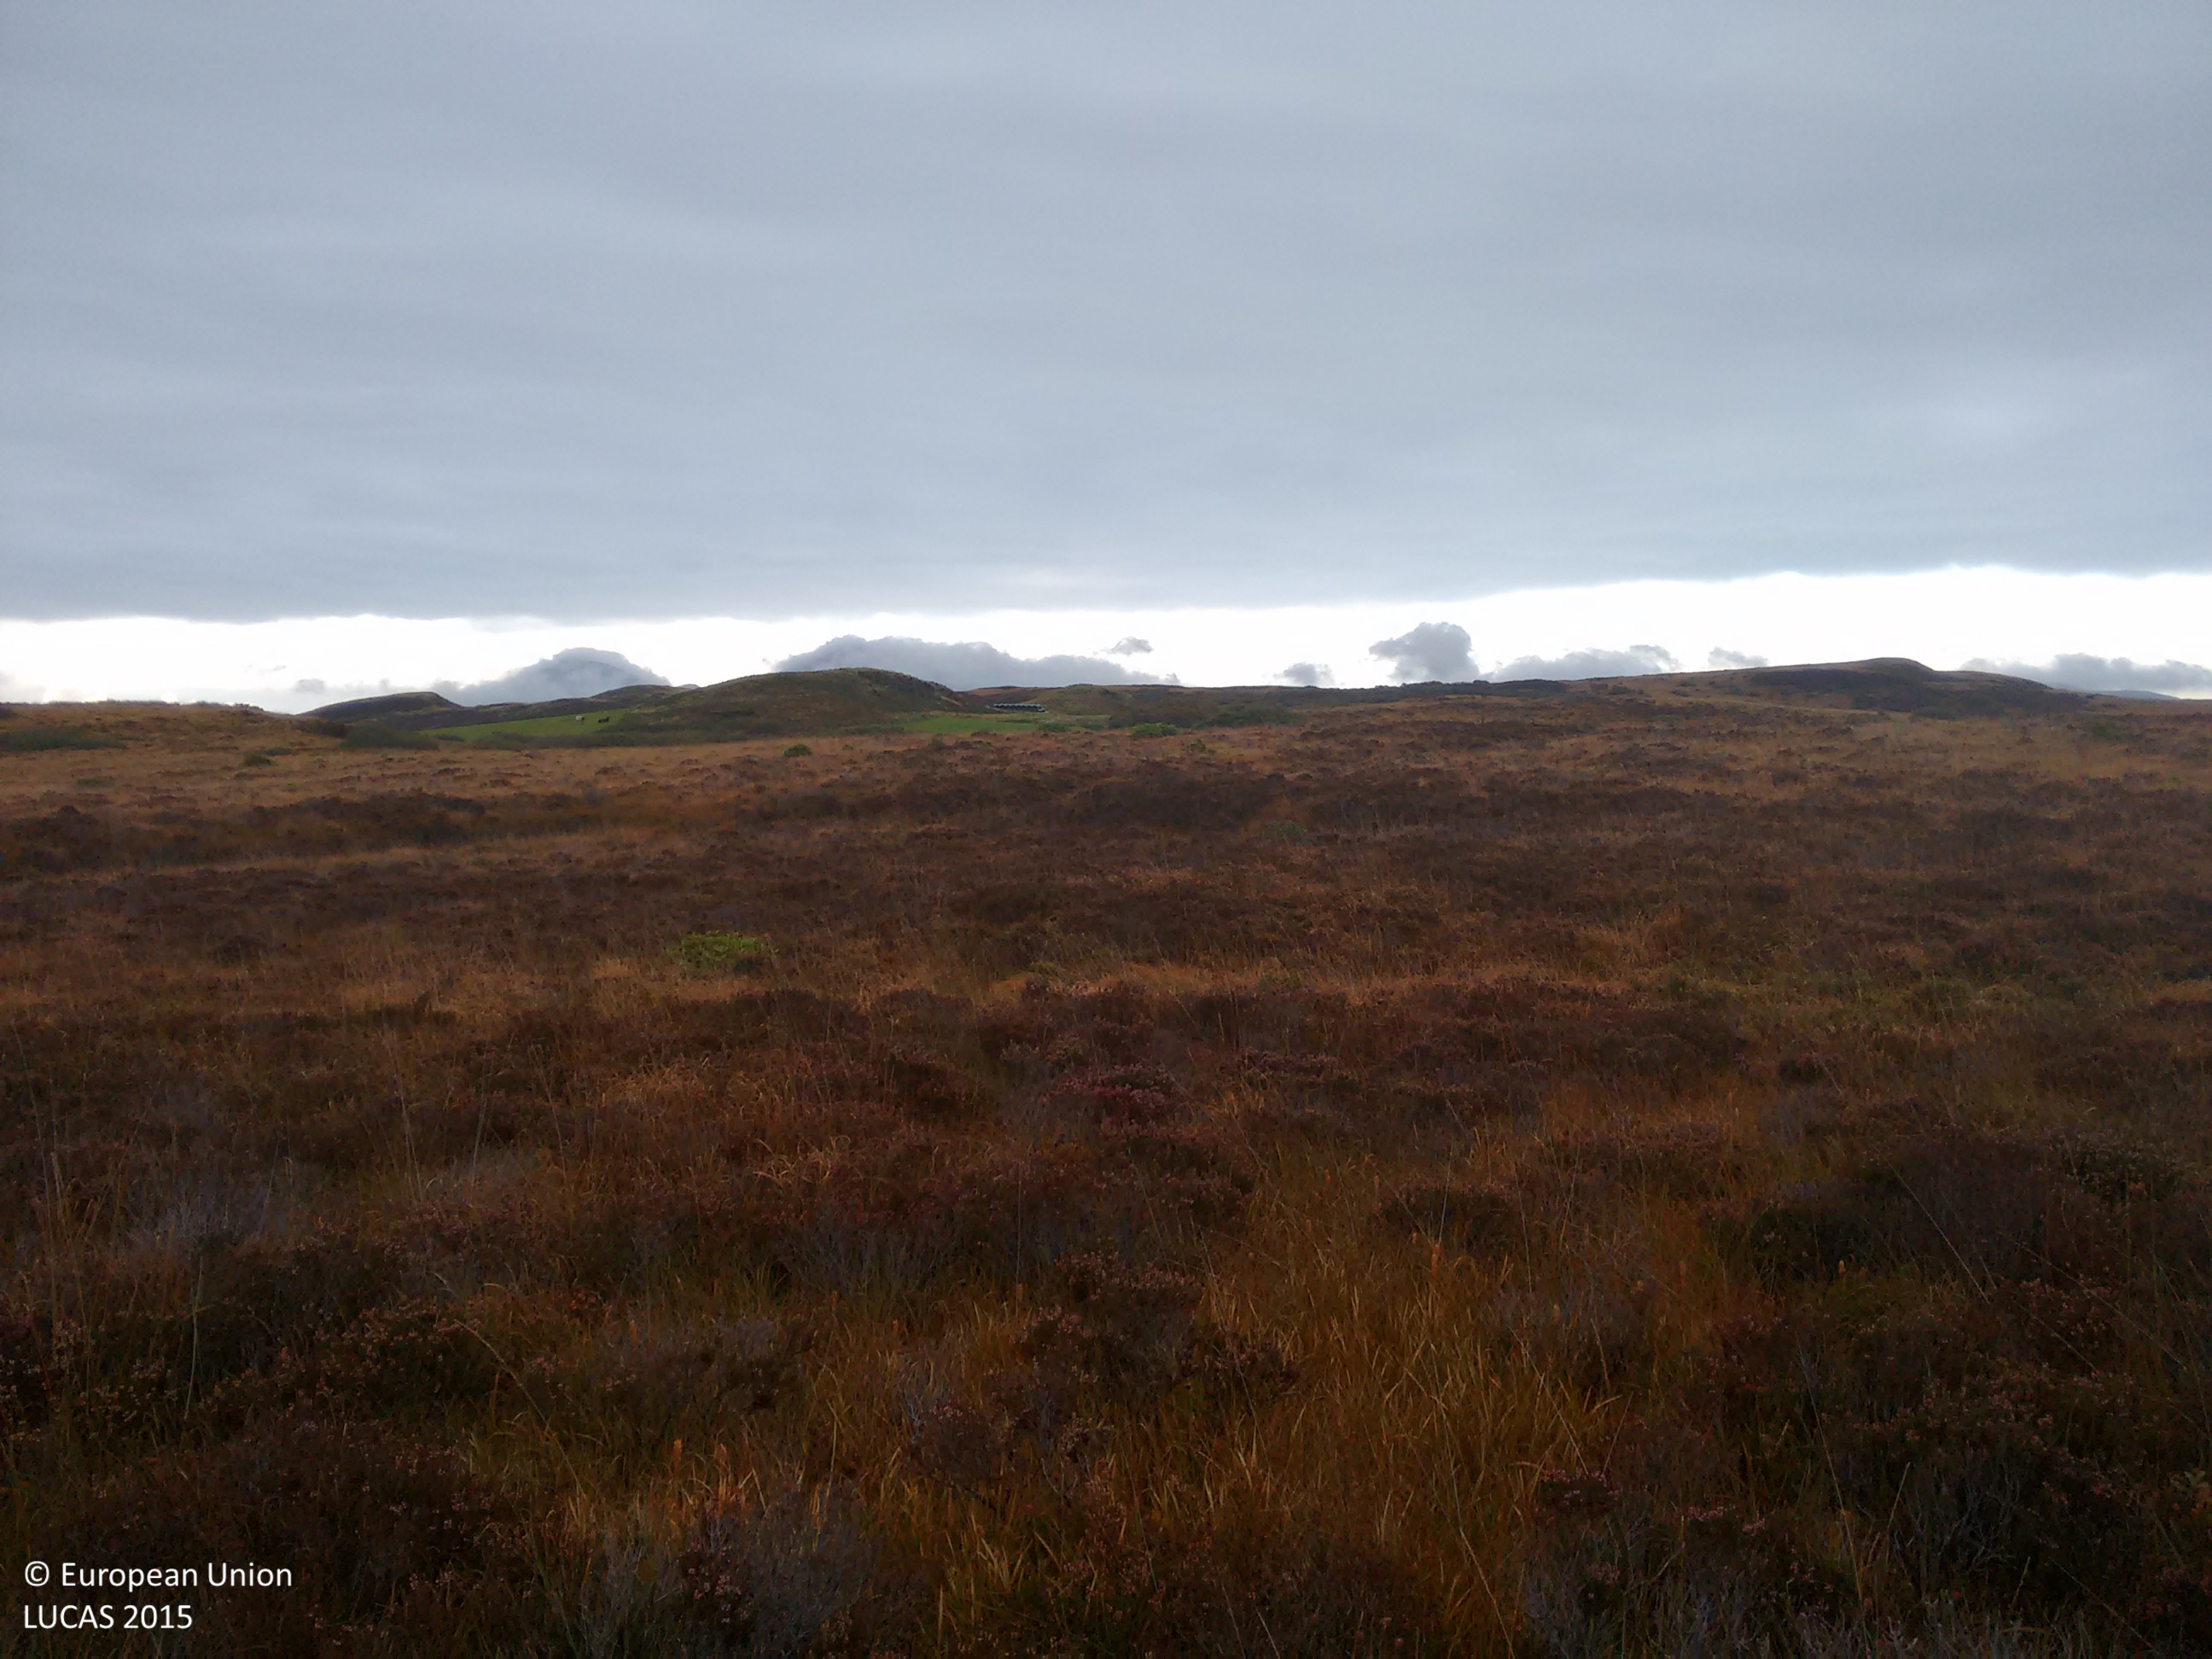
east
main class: Shrubland
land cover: Shrubland without tree cover
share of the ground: > 75 %
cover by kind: shrubs 80 %, herbaceous plants 10 %, lichens and mosses 10 %
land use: Agriculture (excluding fallow land and kitchen gardens)
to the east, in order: Shrubland without tree cover; Tracks; Shrubland without tree cover; Broadleaved woodland
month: October
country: GB
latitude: 55.8729
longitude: -6.1385
